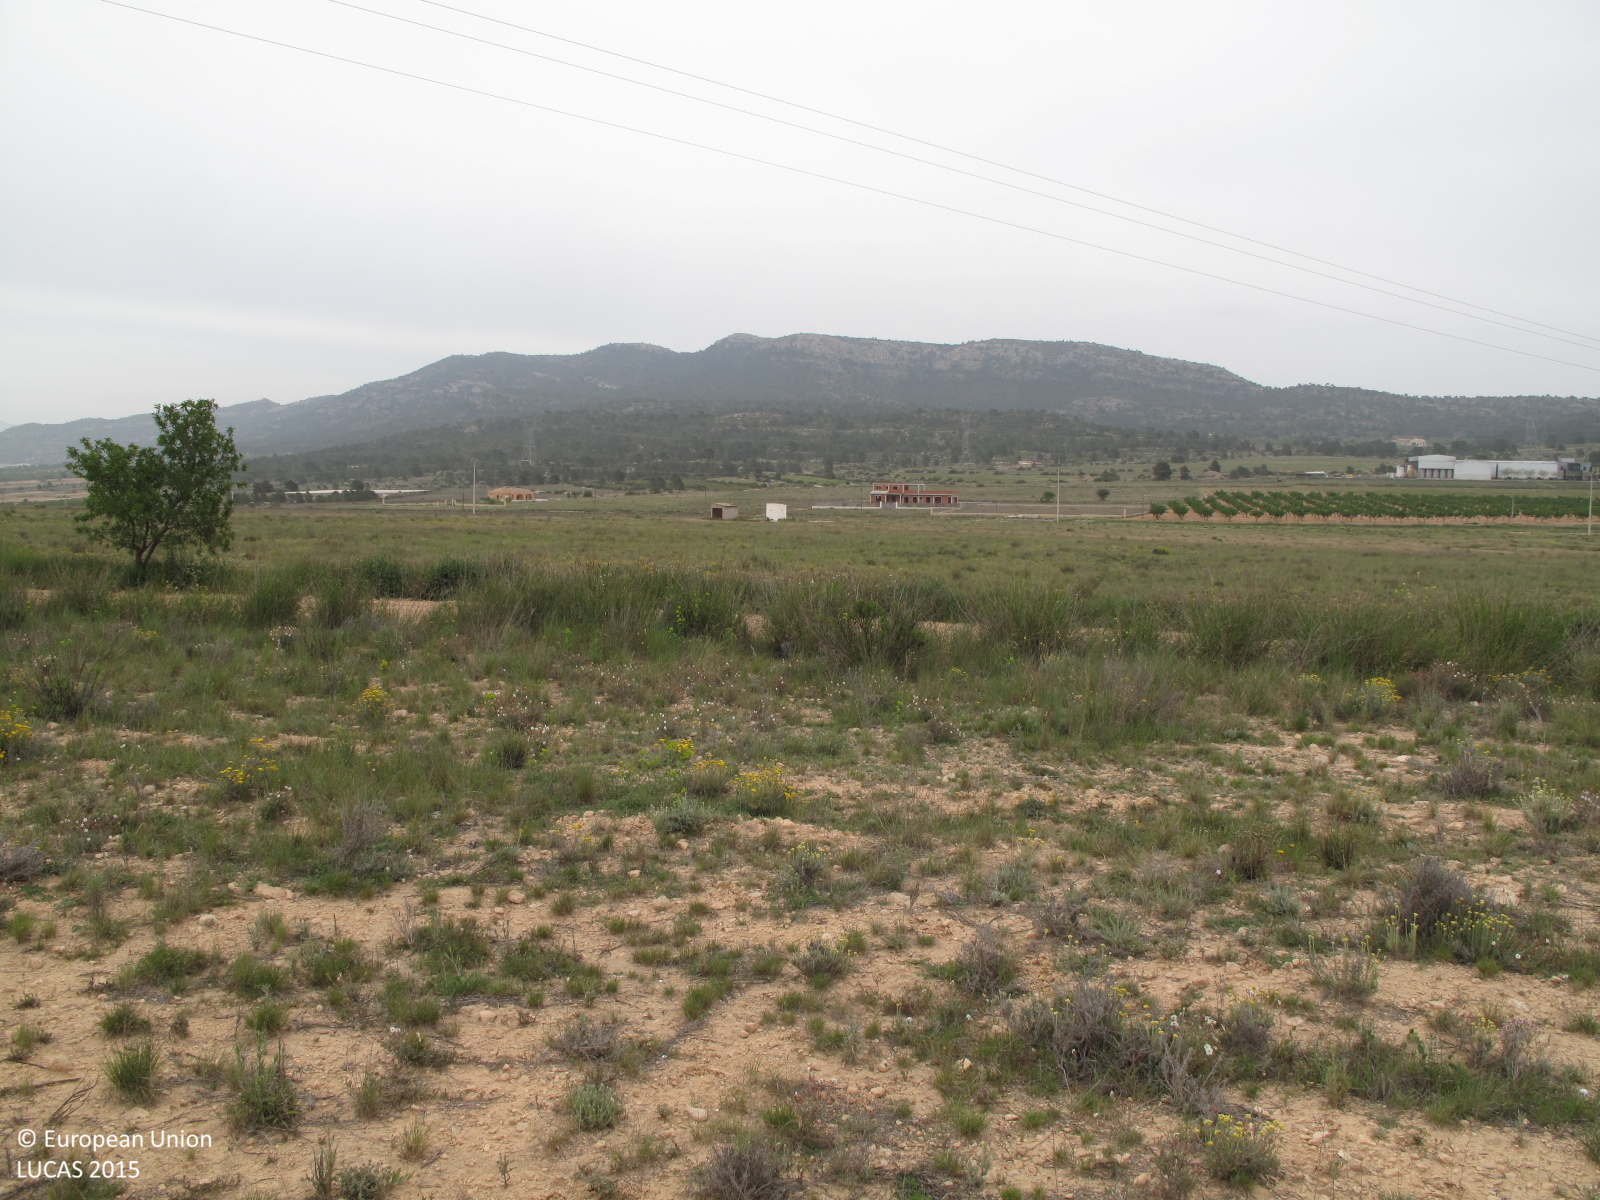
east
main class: Grassland
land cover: Spontaneously vegetated surfaces
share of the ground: 25 - 50 %
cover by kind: consolidated bare surface 55 %, herbaceous plants 45 %
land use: Fallow land
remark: Fire break
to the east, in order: Other structural elements; Spontaneously vegetated surfaces; Other bare soil; Grass margins; Other bare soil; Spontaneously vegetated surfaces; Electric lines; Spontaneously vegetated surfaces; Tracks; Spontaneously vegetated surfaces
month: April
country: ES
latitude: 38.4703
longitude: -0.9116
